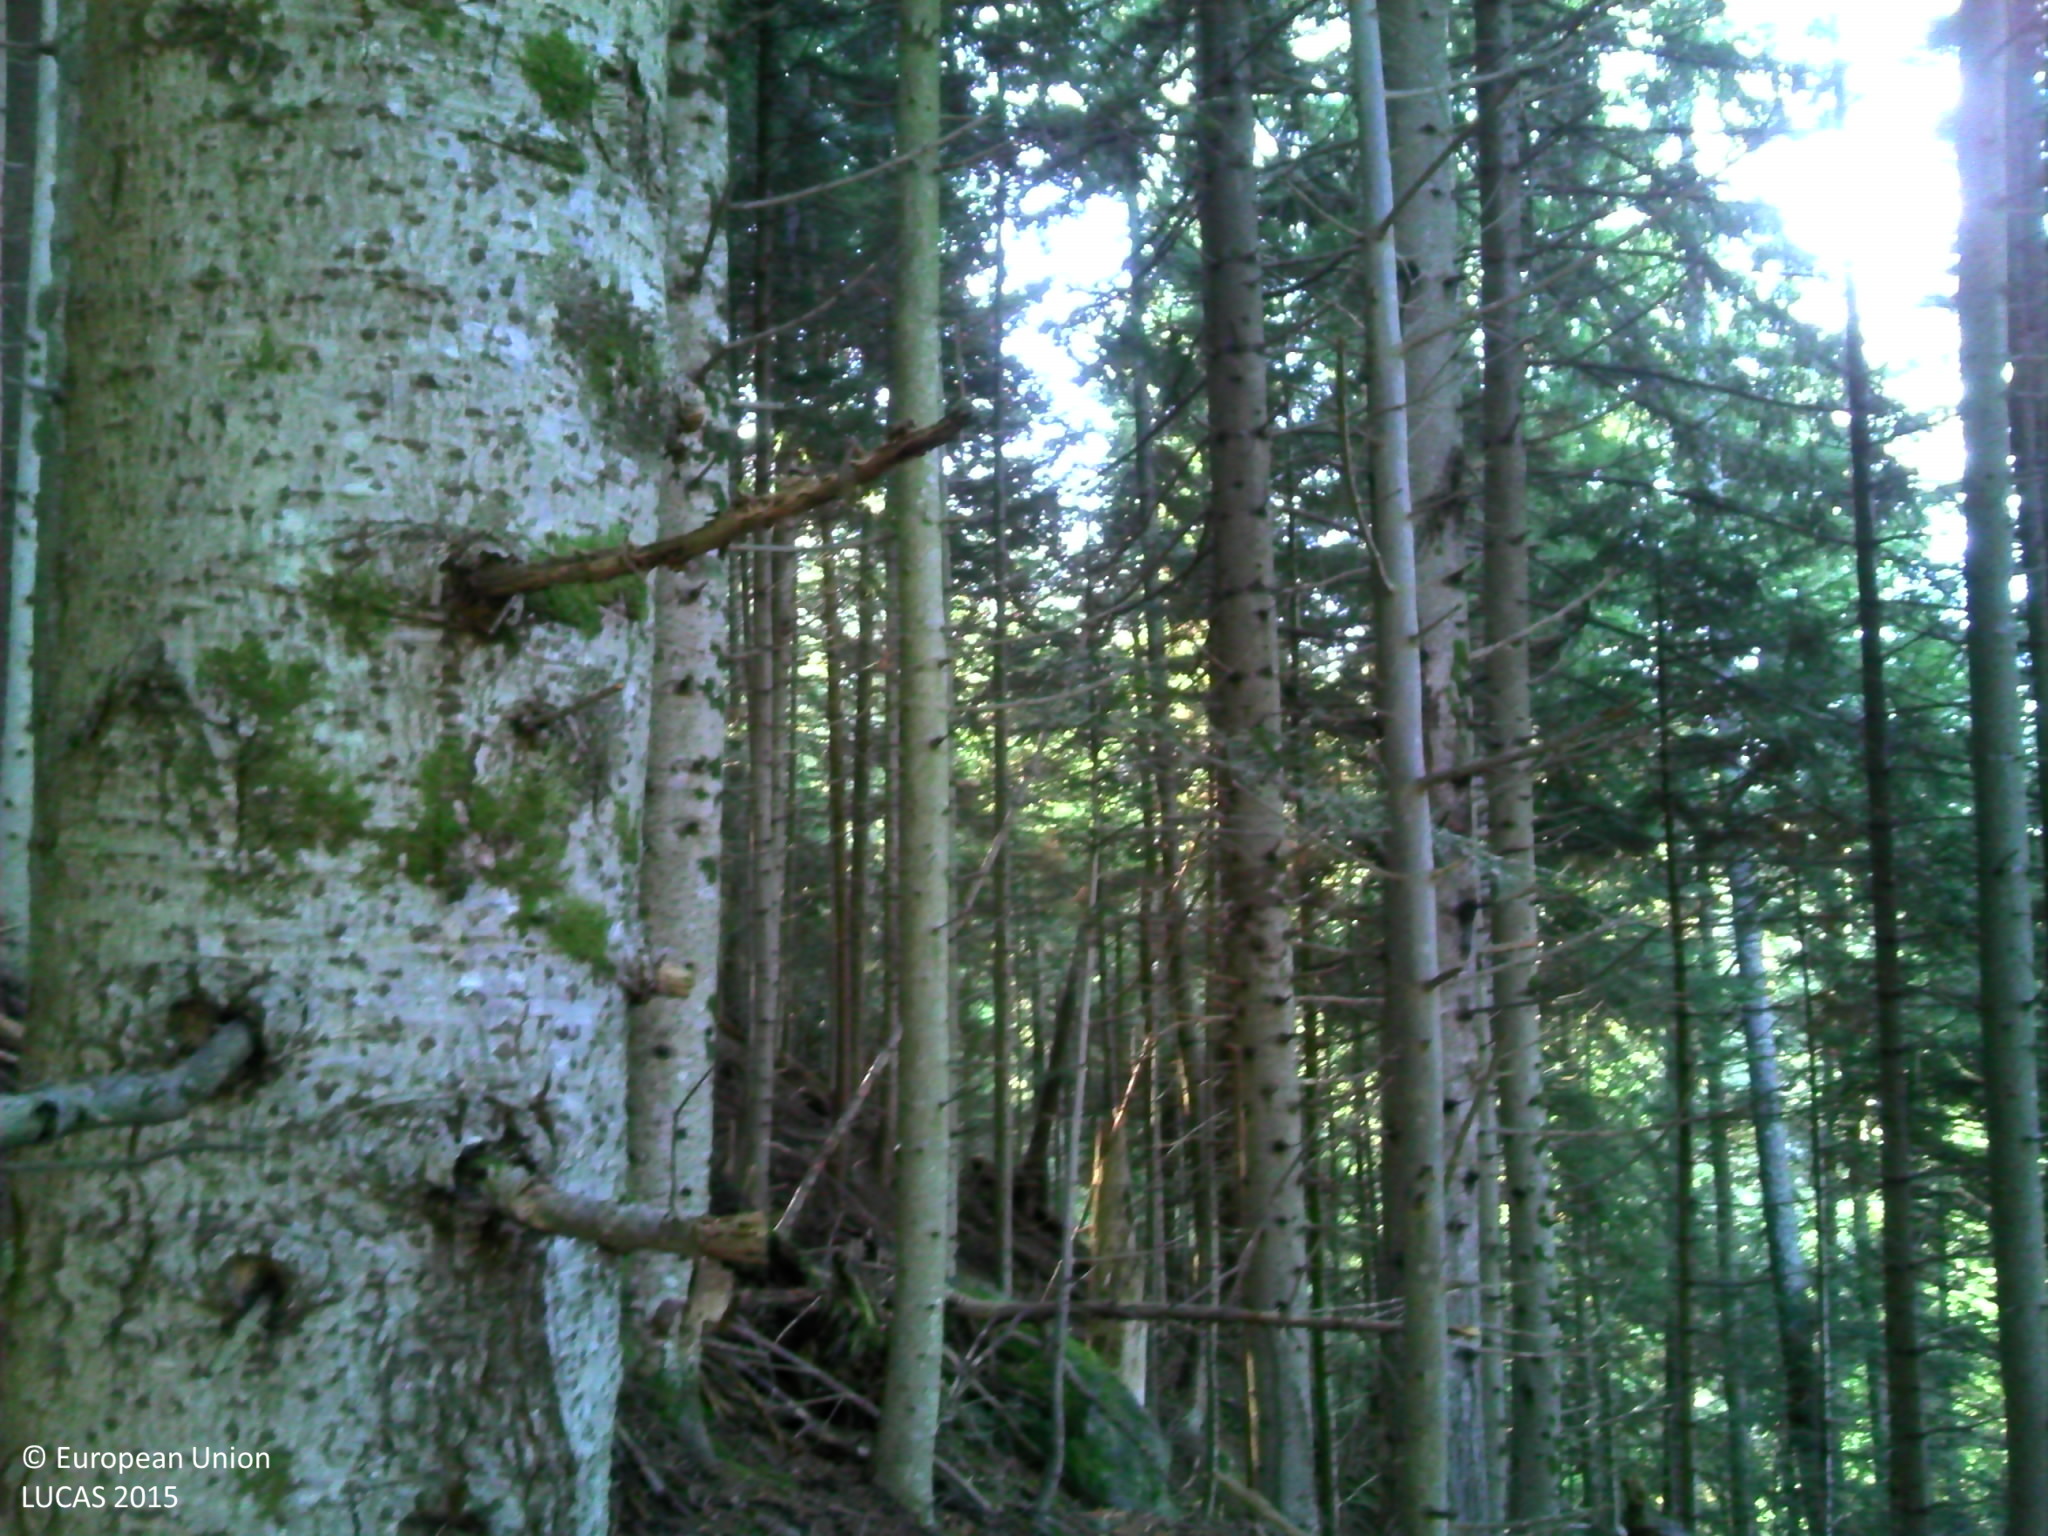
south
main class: Woodland
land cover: Spruce dominated coniferous woodland
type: alpine coniferous forest
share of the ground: > 75 %
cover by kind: coniferous forest trees 95 %, consolidated bare surface 5 %
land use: Forestry
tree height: > 5 m
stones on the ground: < 10 %
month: October
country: FR
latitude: 45.3337
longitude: 6.3683
